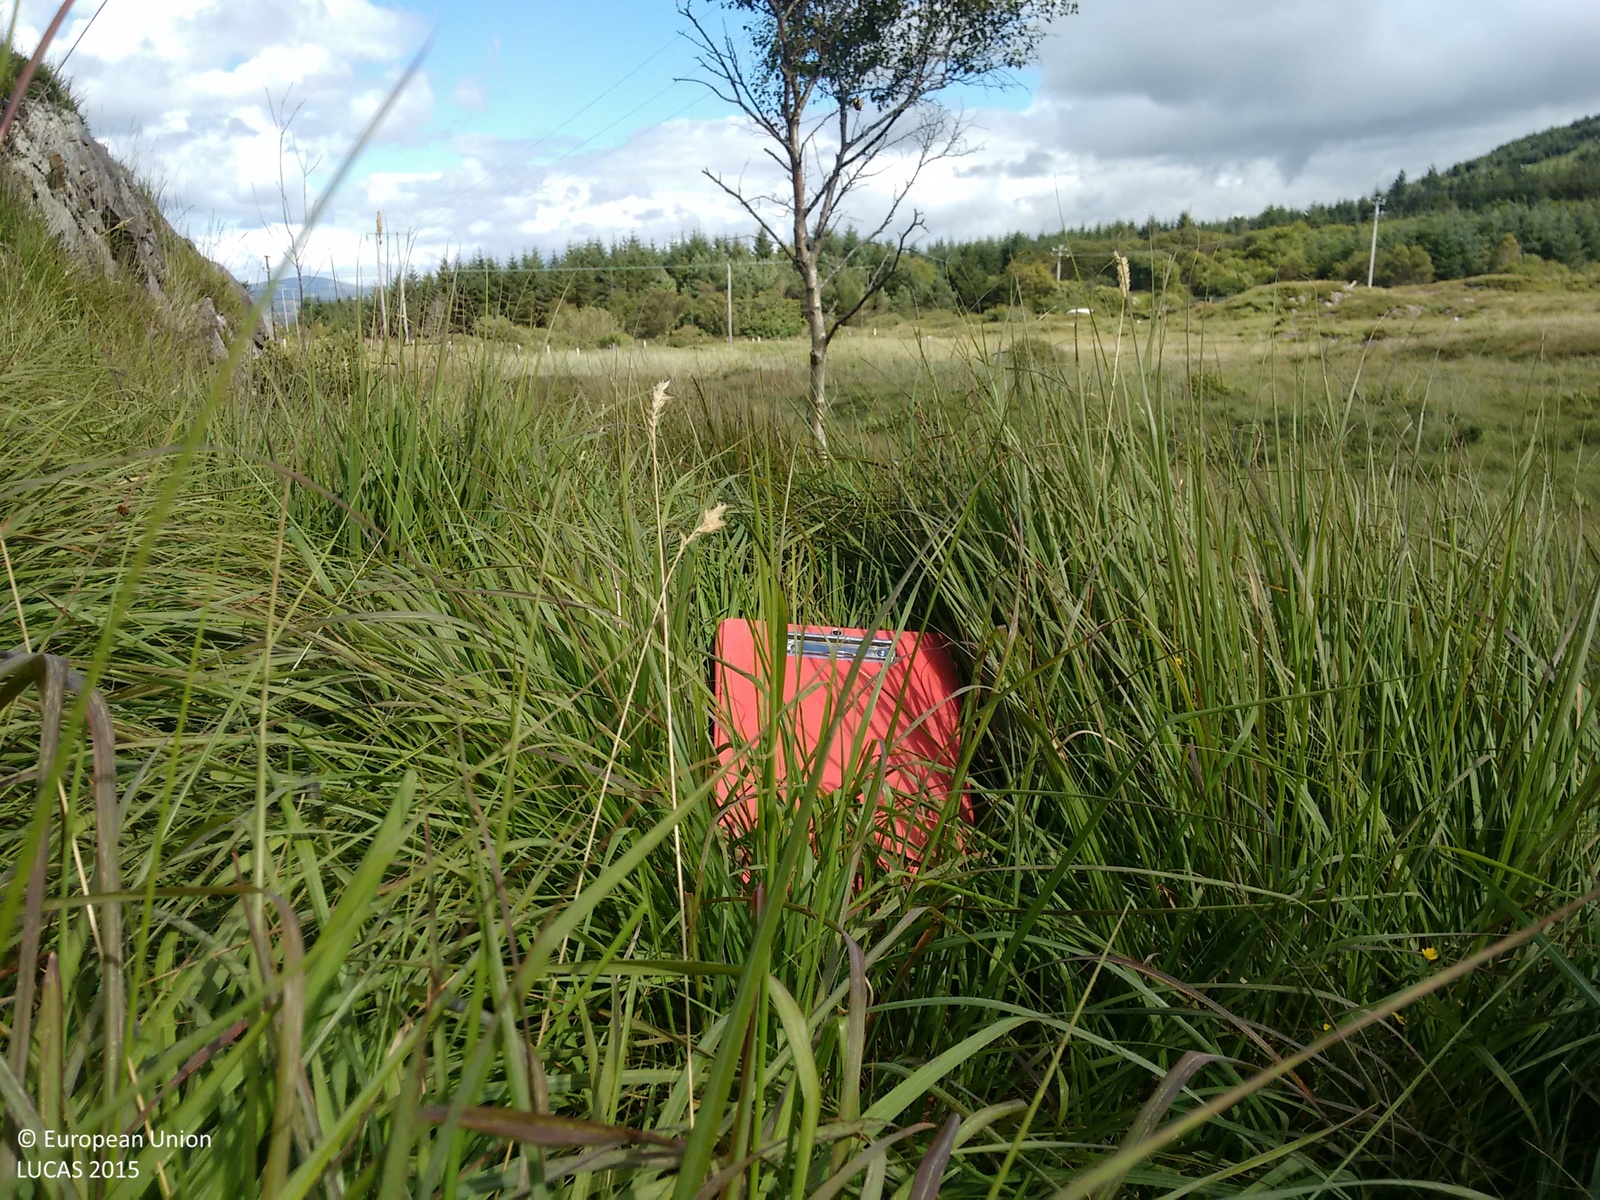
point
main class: Grassland
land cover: Grassland without tree/shrub cover
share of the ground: > 75 %
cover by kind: herbaceous plants 60 %, consolidated bare surface 40 %
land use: Semi-natural and natural areas not in use
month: August
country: IE
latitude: 51.7406
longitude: -9.4786
